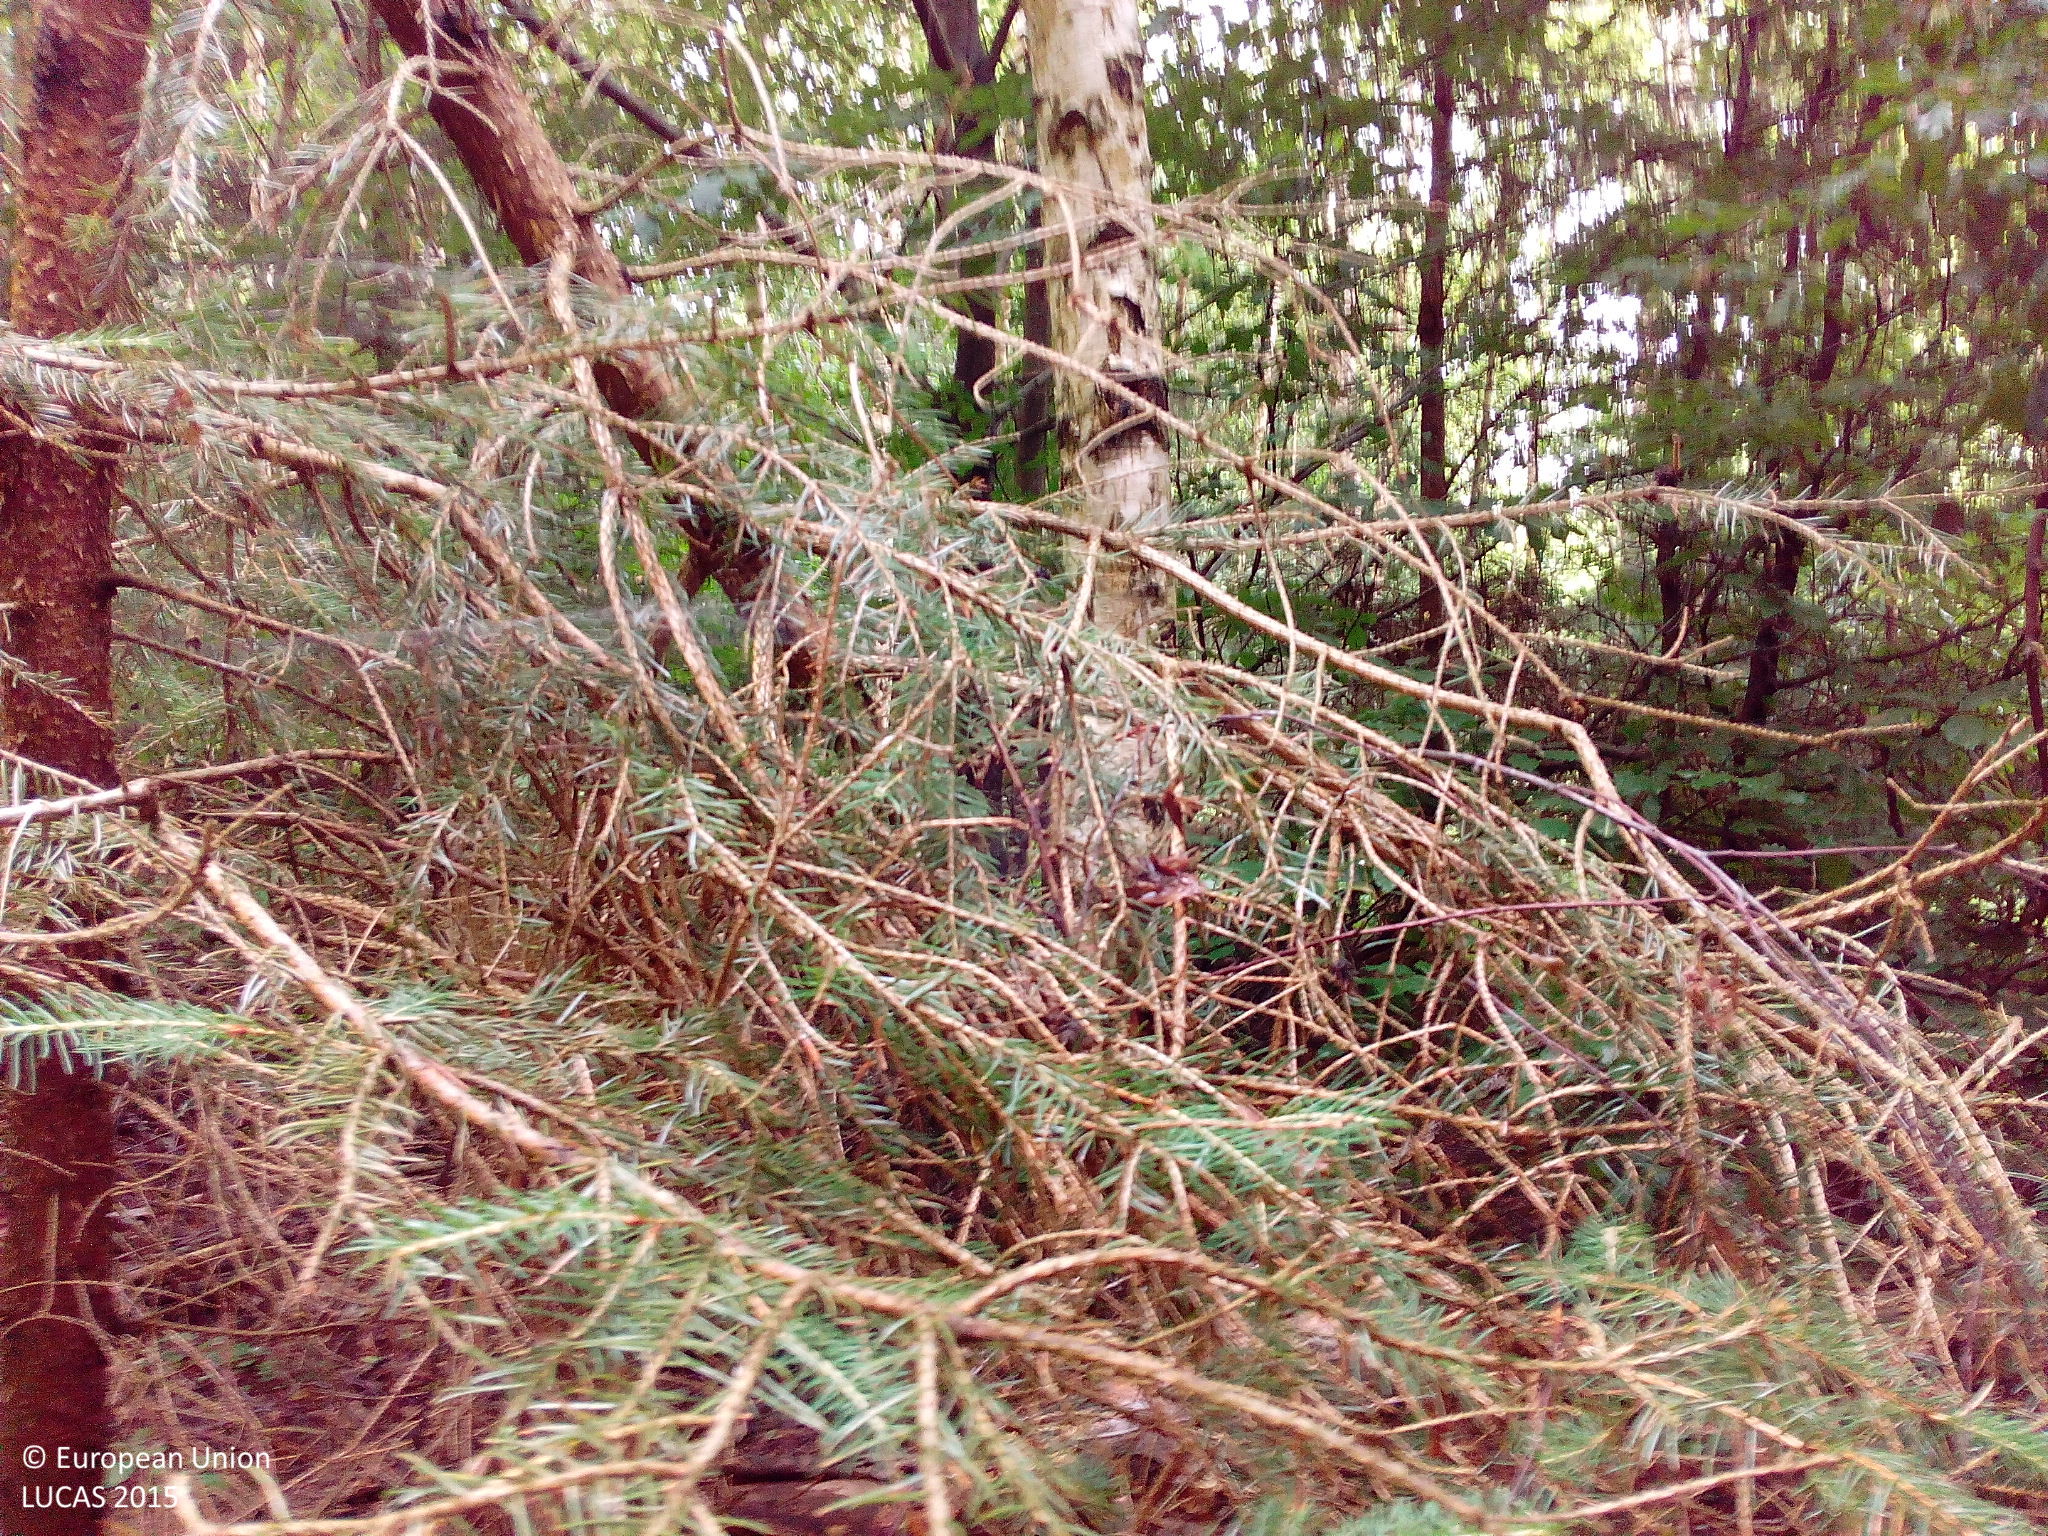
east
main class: Woodland
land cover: Spruce dominated mixed woodland
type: hemiboreal forest and nemoral coniferous forest and mixed broadleaved-coniferous forest
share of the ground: > 75 %
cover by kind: broadleaved forest trees 65 %, coniferous forest trees 25 %, herbaceous plants 10 %
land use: Forestry
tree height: > 5 m
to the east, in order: Spruce dominated mixed woodland; Broadleaved woodland; Tracks; Spruce dominated mixed woodland; Broadleaved woodland
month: July
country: DE
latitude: 50.8674
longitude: 9.9290
